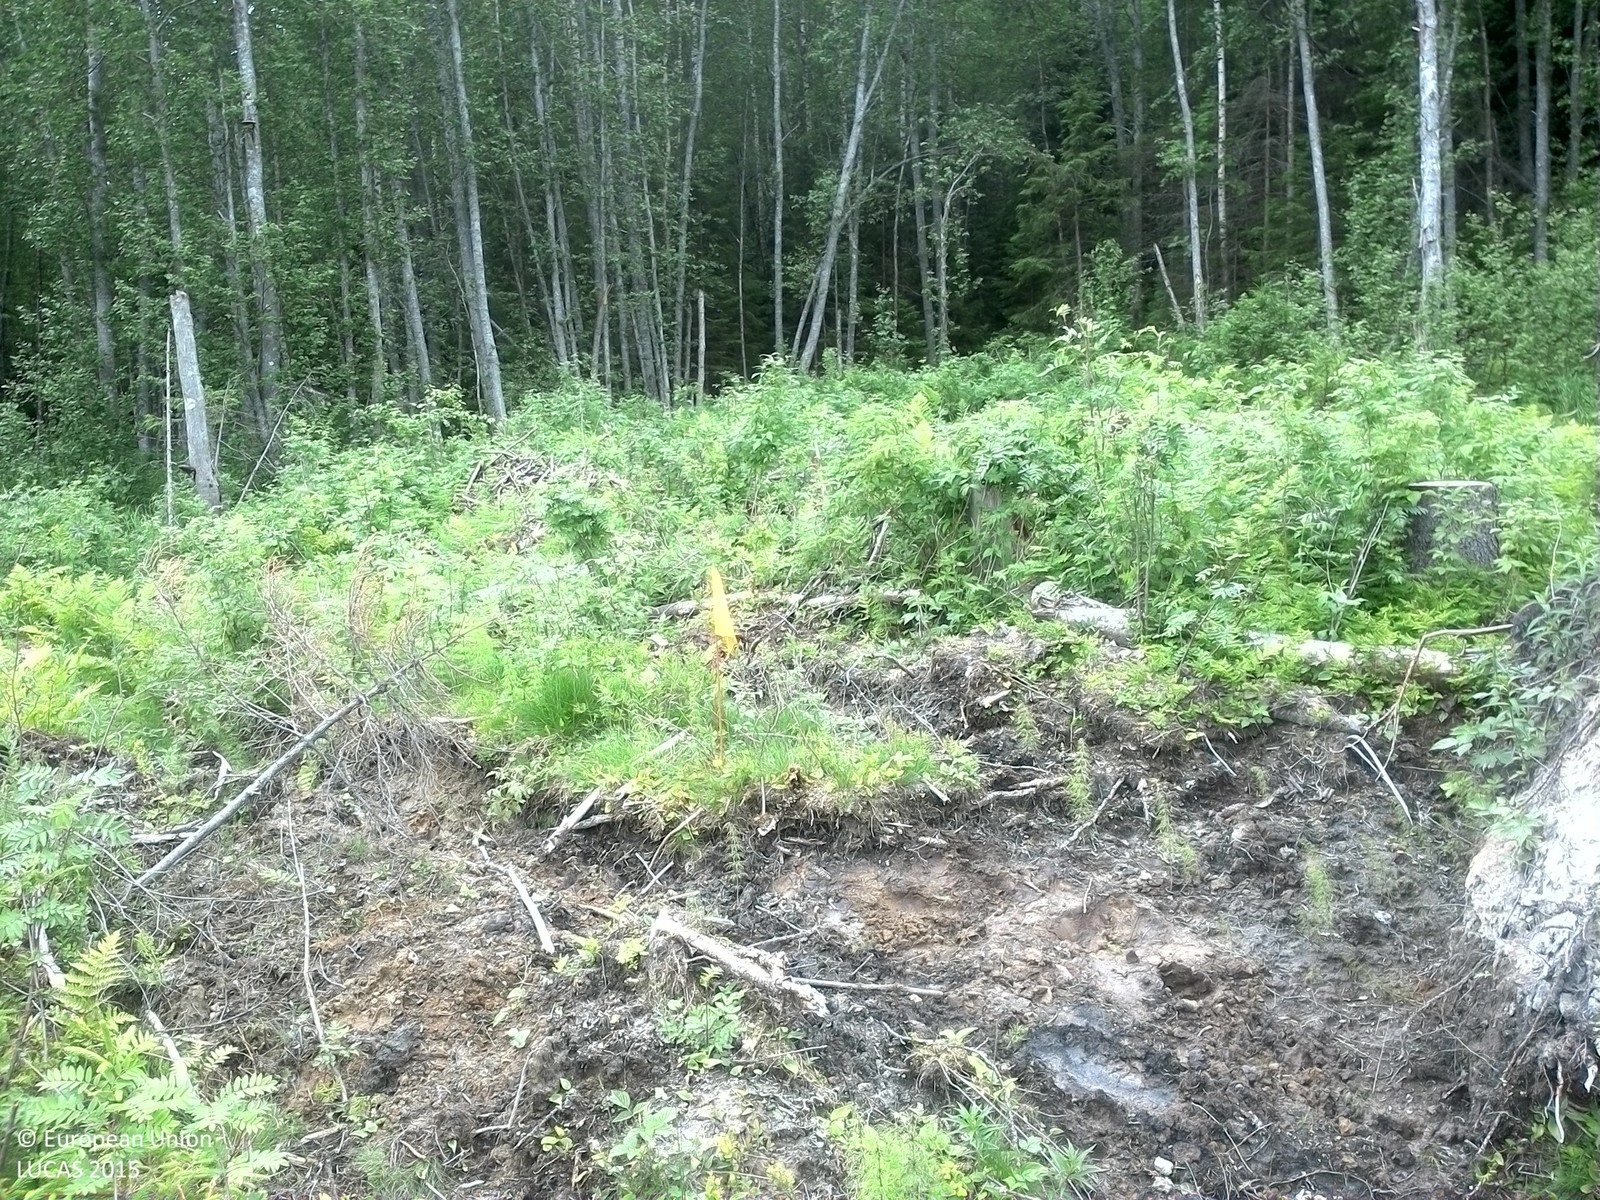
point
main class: Woodland
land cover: Broadleaved woodland
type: boreal forest
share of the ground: 10 - 25 %
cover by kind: shrubs 40 %, broadleaved forest trees 25 %, herbaceous plants 25 %, unconsolidated bare surface 10 %
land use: Forestry
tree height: < 5 m
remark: Clear cut
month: July
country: SE
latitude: 62.6555
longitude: 17.6095
